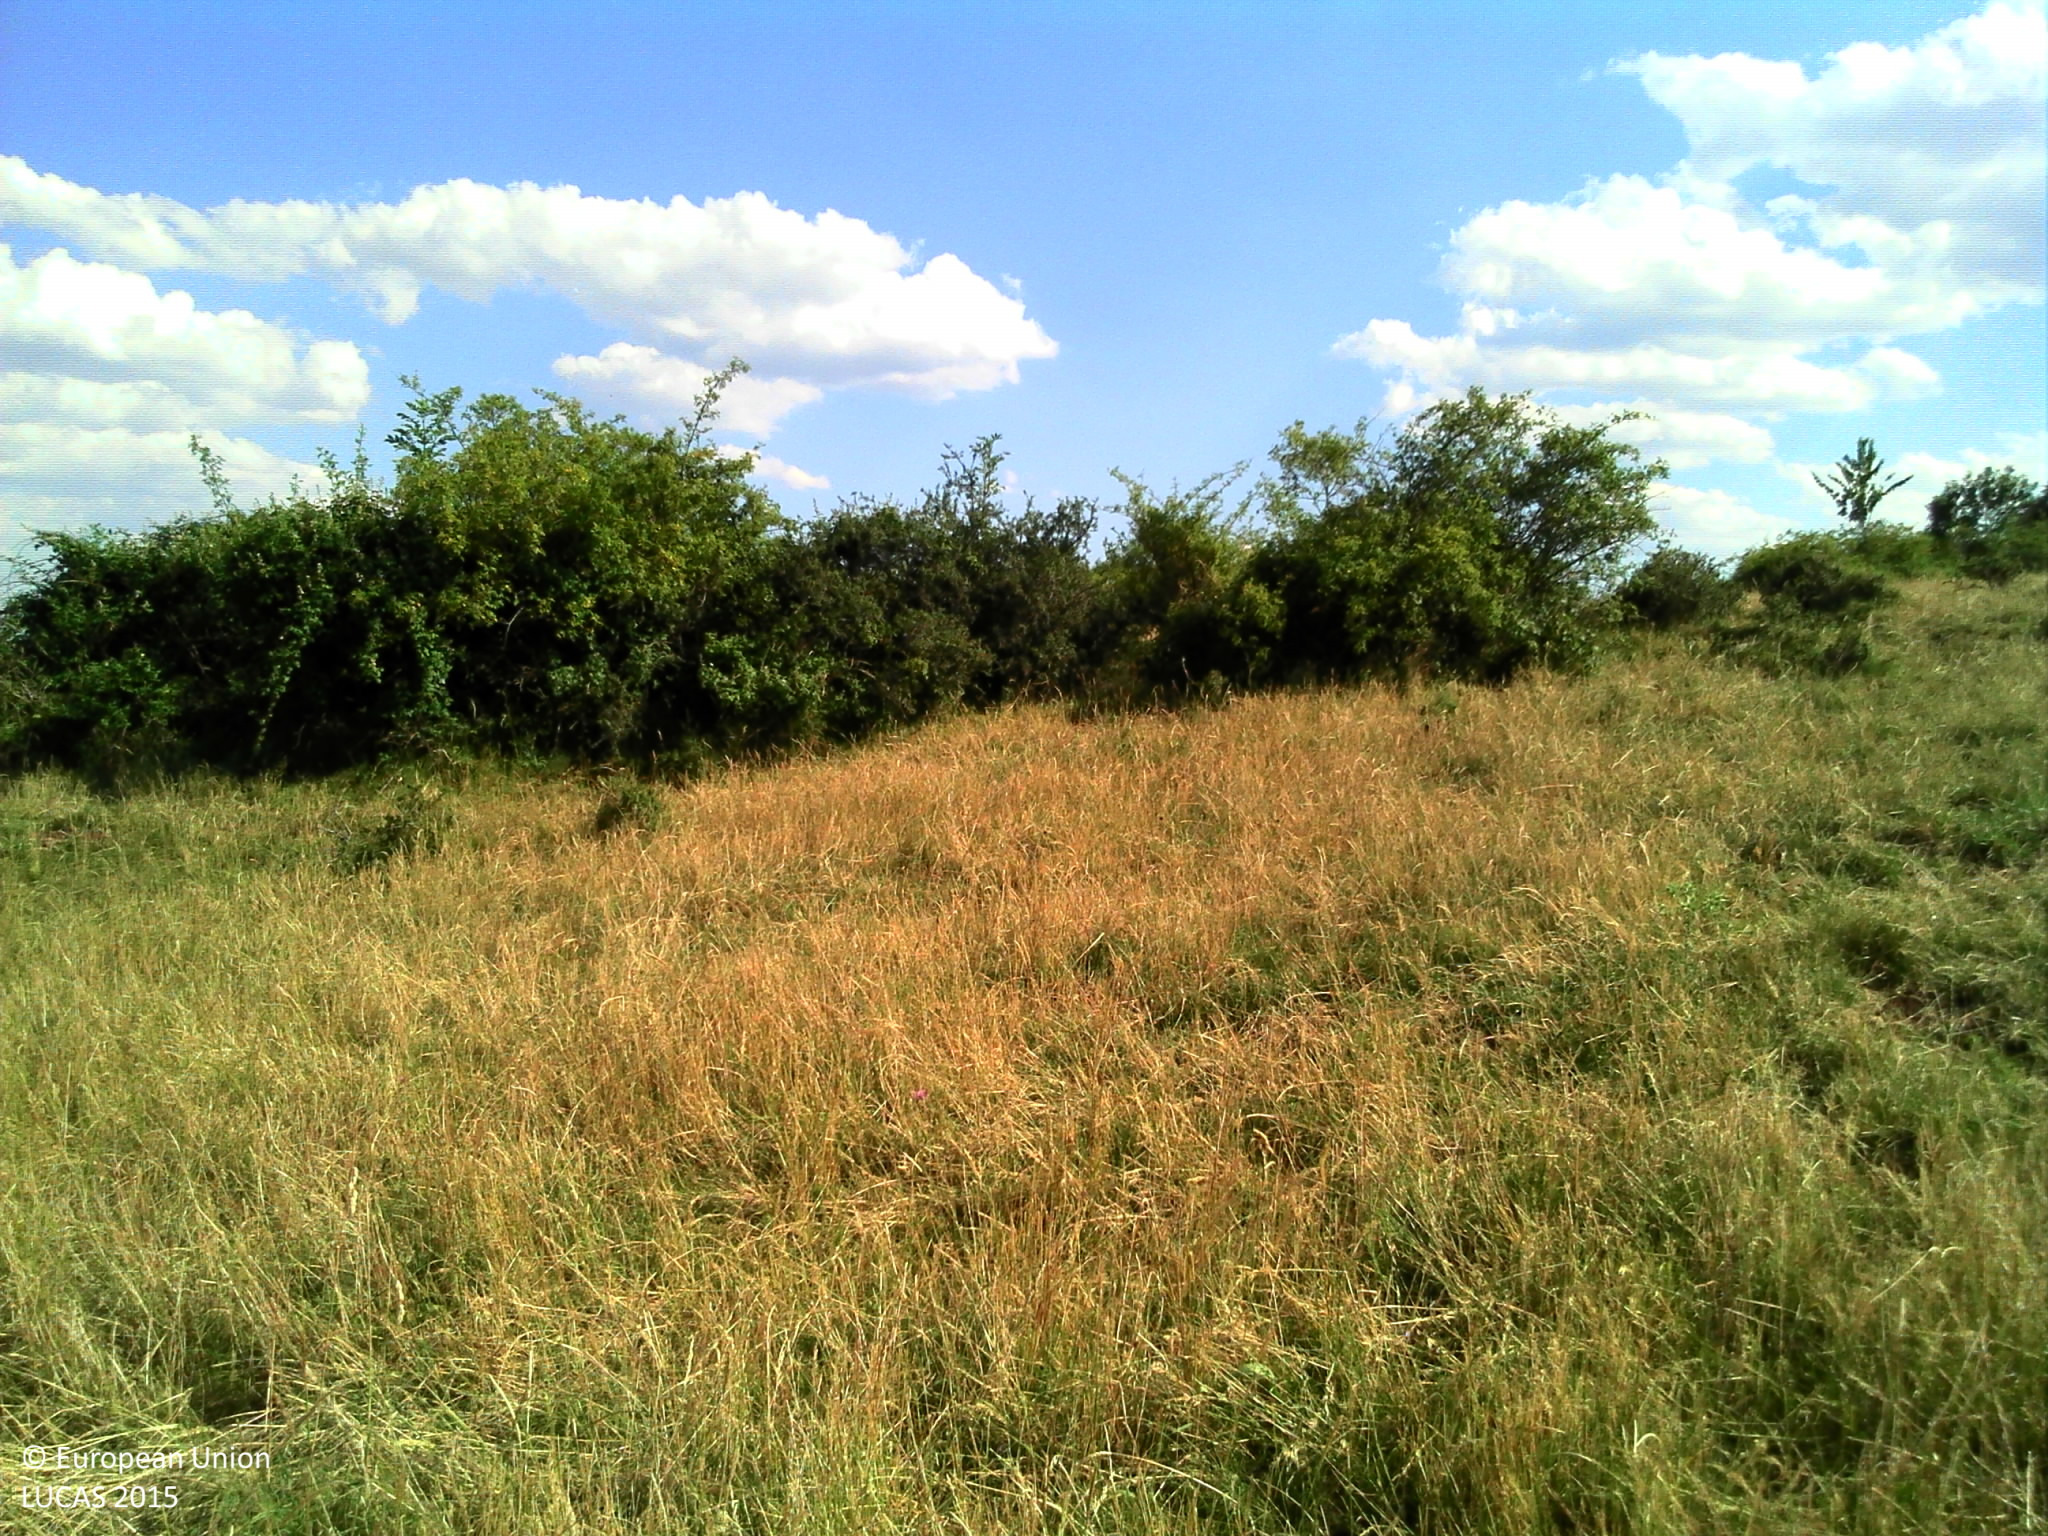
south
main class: Grassland
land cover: Grassland without tree/shrub cover
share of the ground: > 75 %
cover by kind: herbaceous plants 100 %
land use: Agriculture (excluding fallow land and kitchen gardens)
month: June
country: FR
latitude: 45.5137
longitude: 3.1010
